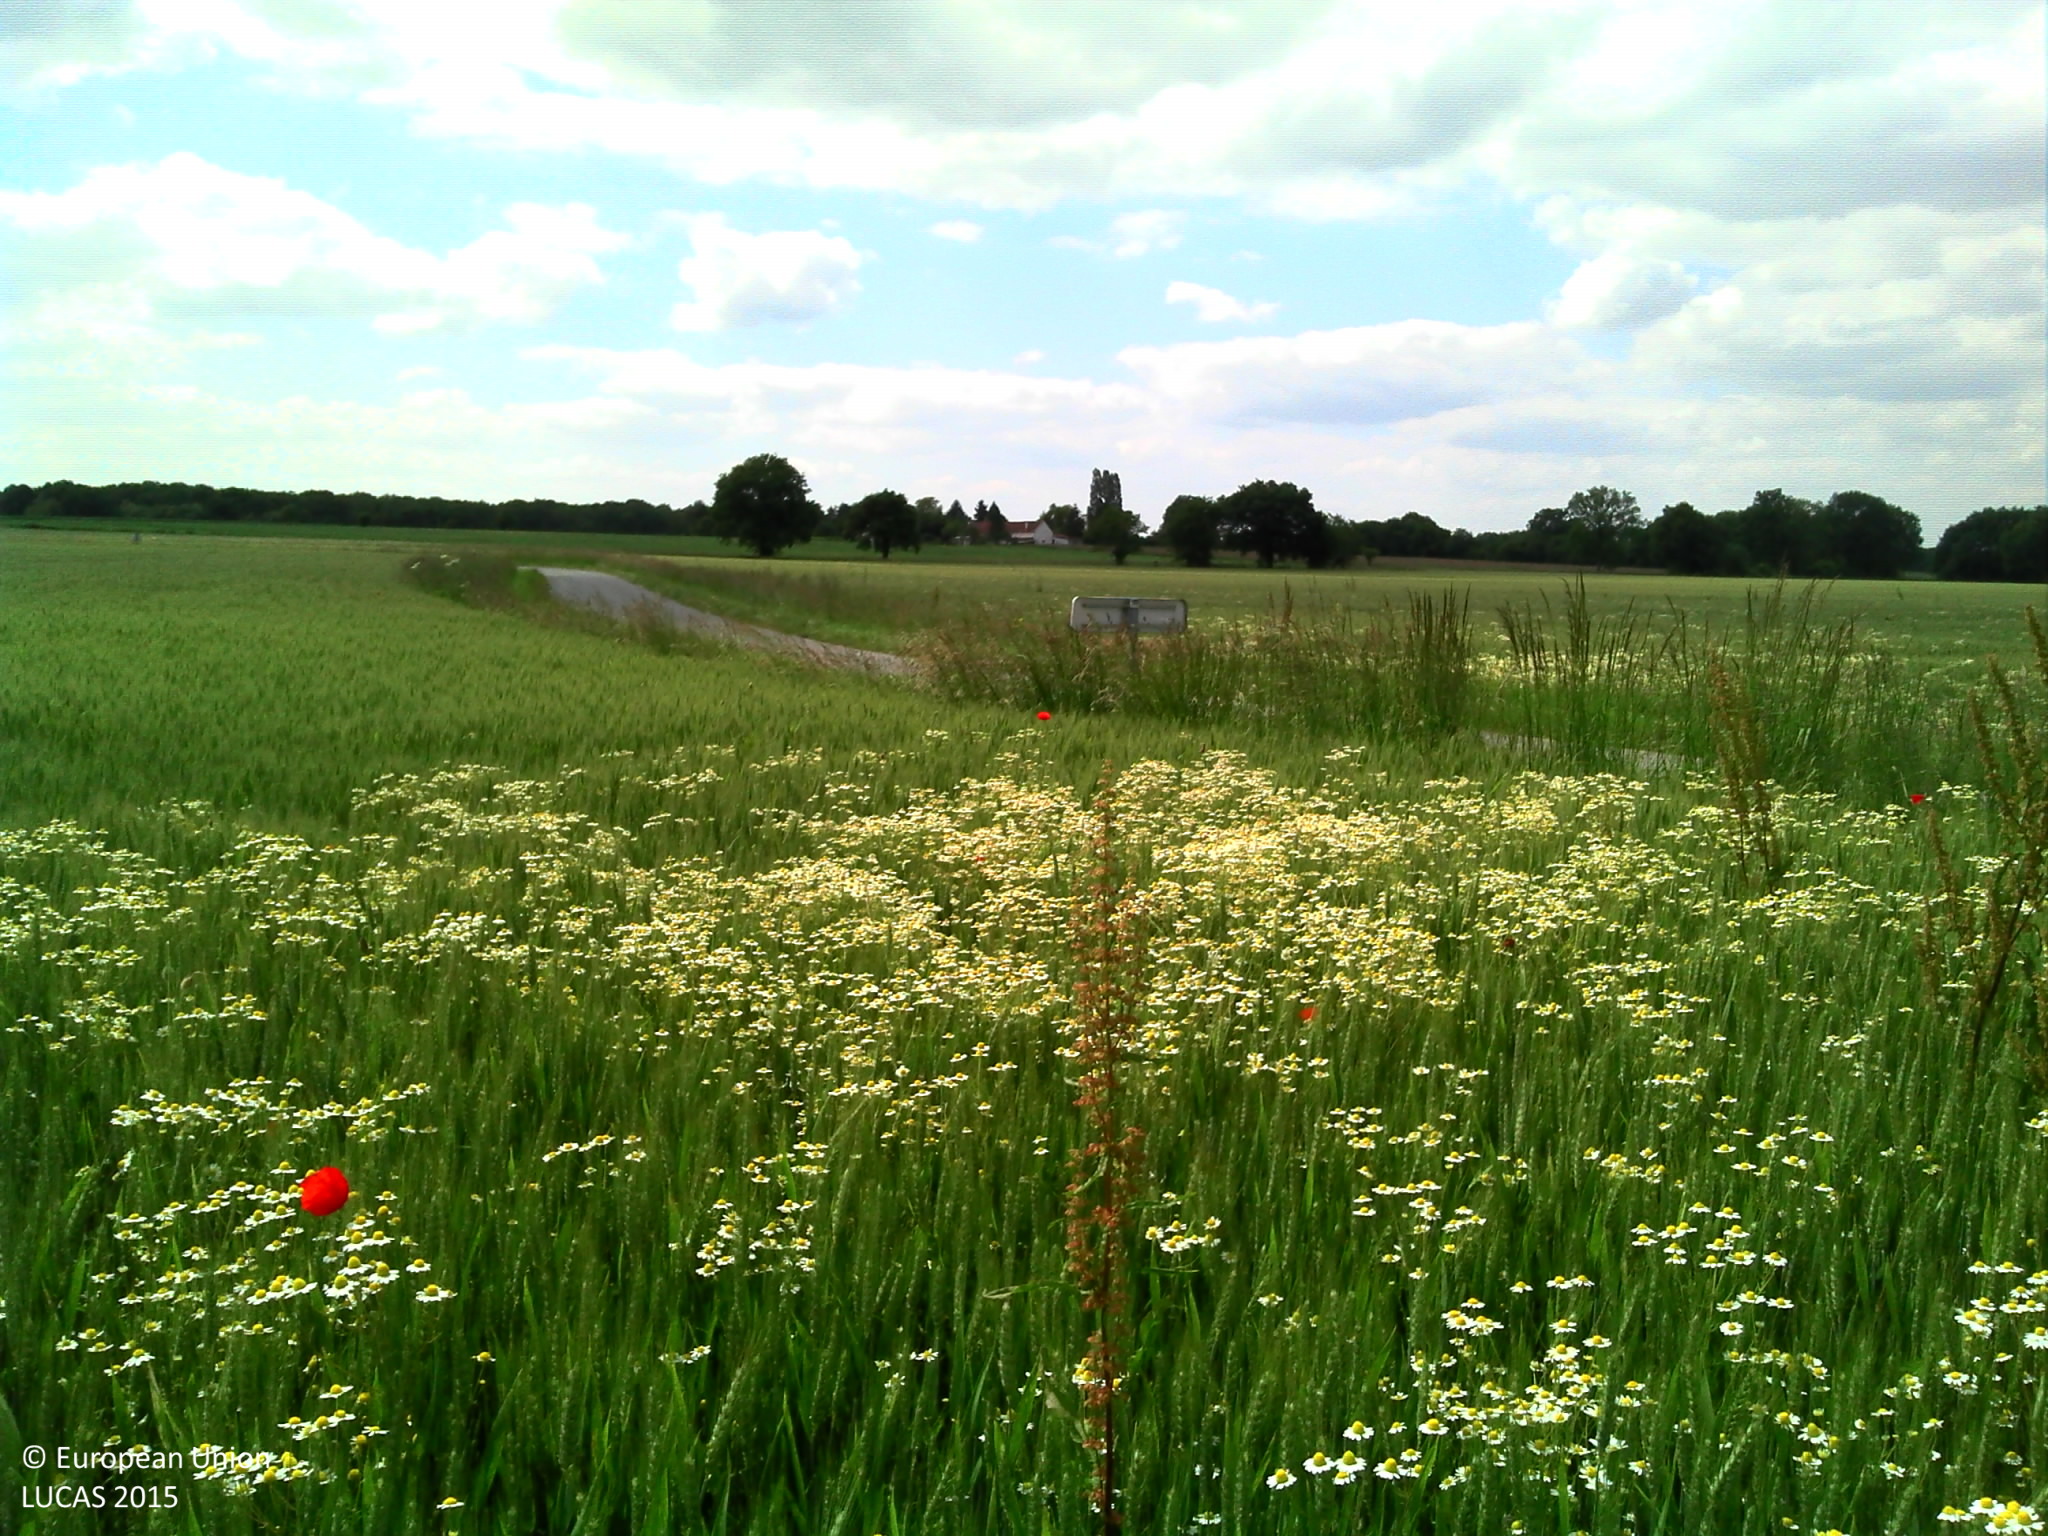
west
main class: Cropland
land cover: Common wheat
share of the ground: > 75 %
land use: Agriculture (excluding fallow land and kitchen gardens)
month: May
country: FR
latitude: 47.2554
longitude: 2.9251
